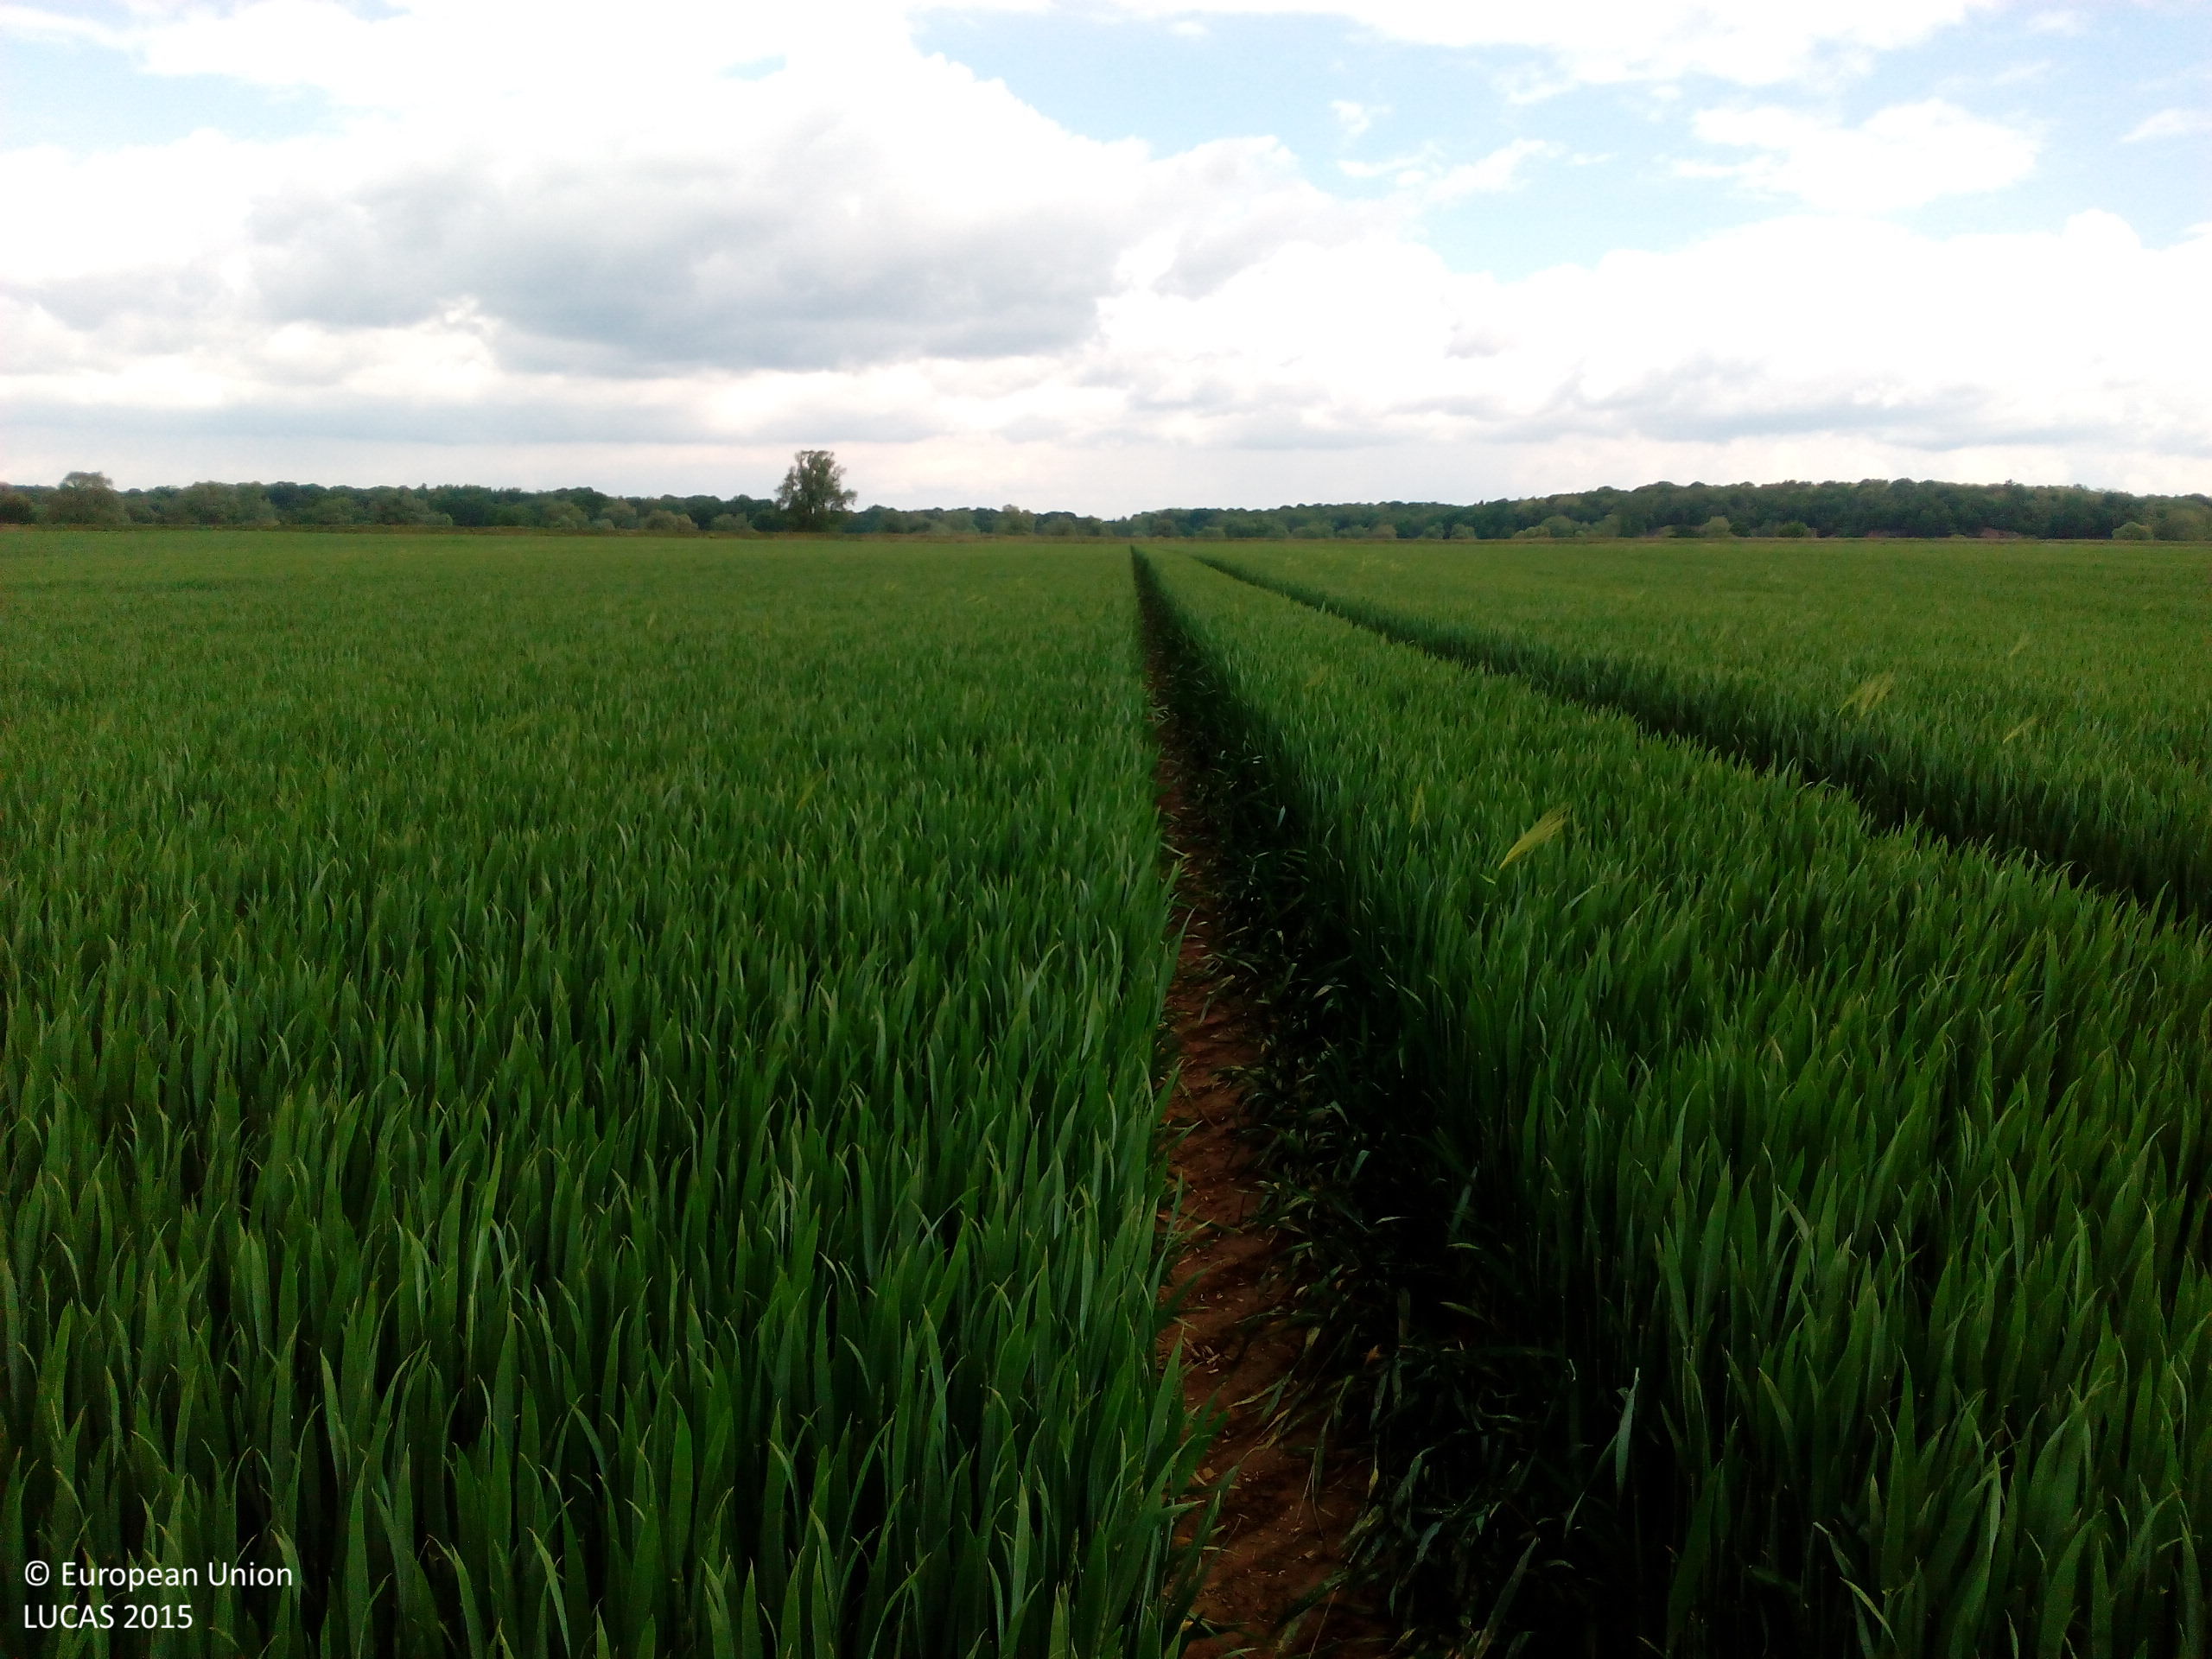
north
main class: Cropland
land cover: Common wheat
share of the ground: > 75 %
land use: Agriculture (excluding fallow land and kitchen gardens)
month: May
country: DE
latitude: 51.5947
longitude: 12.5549
